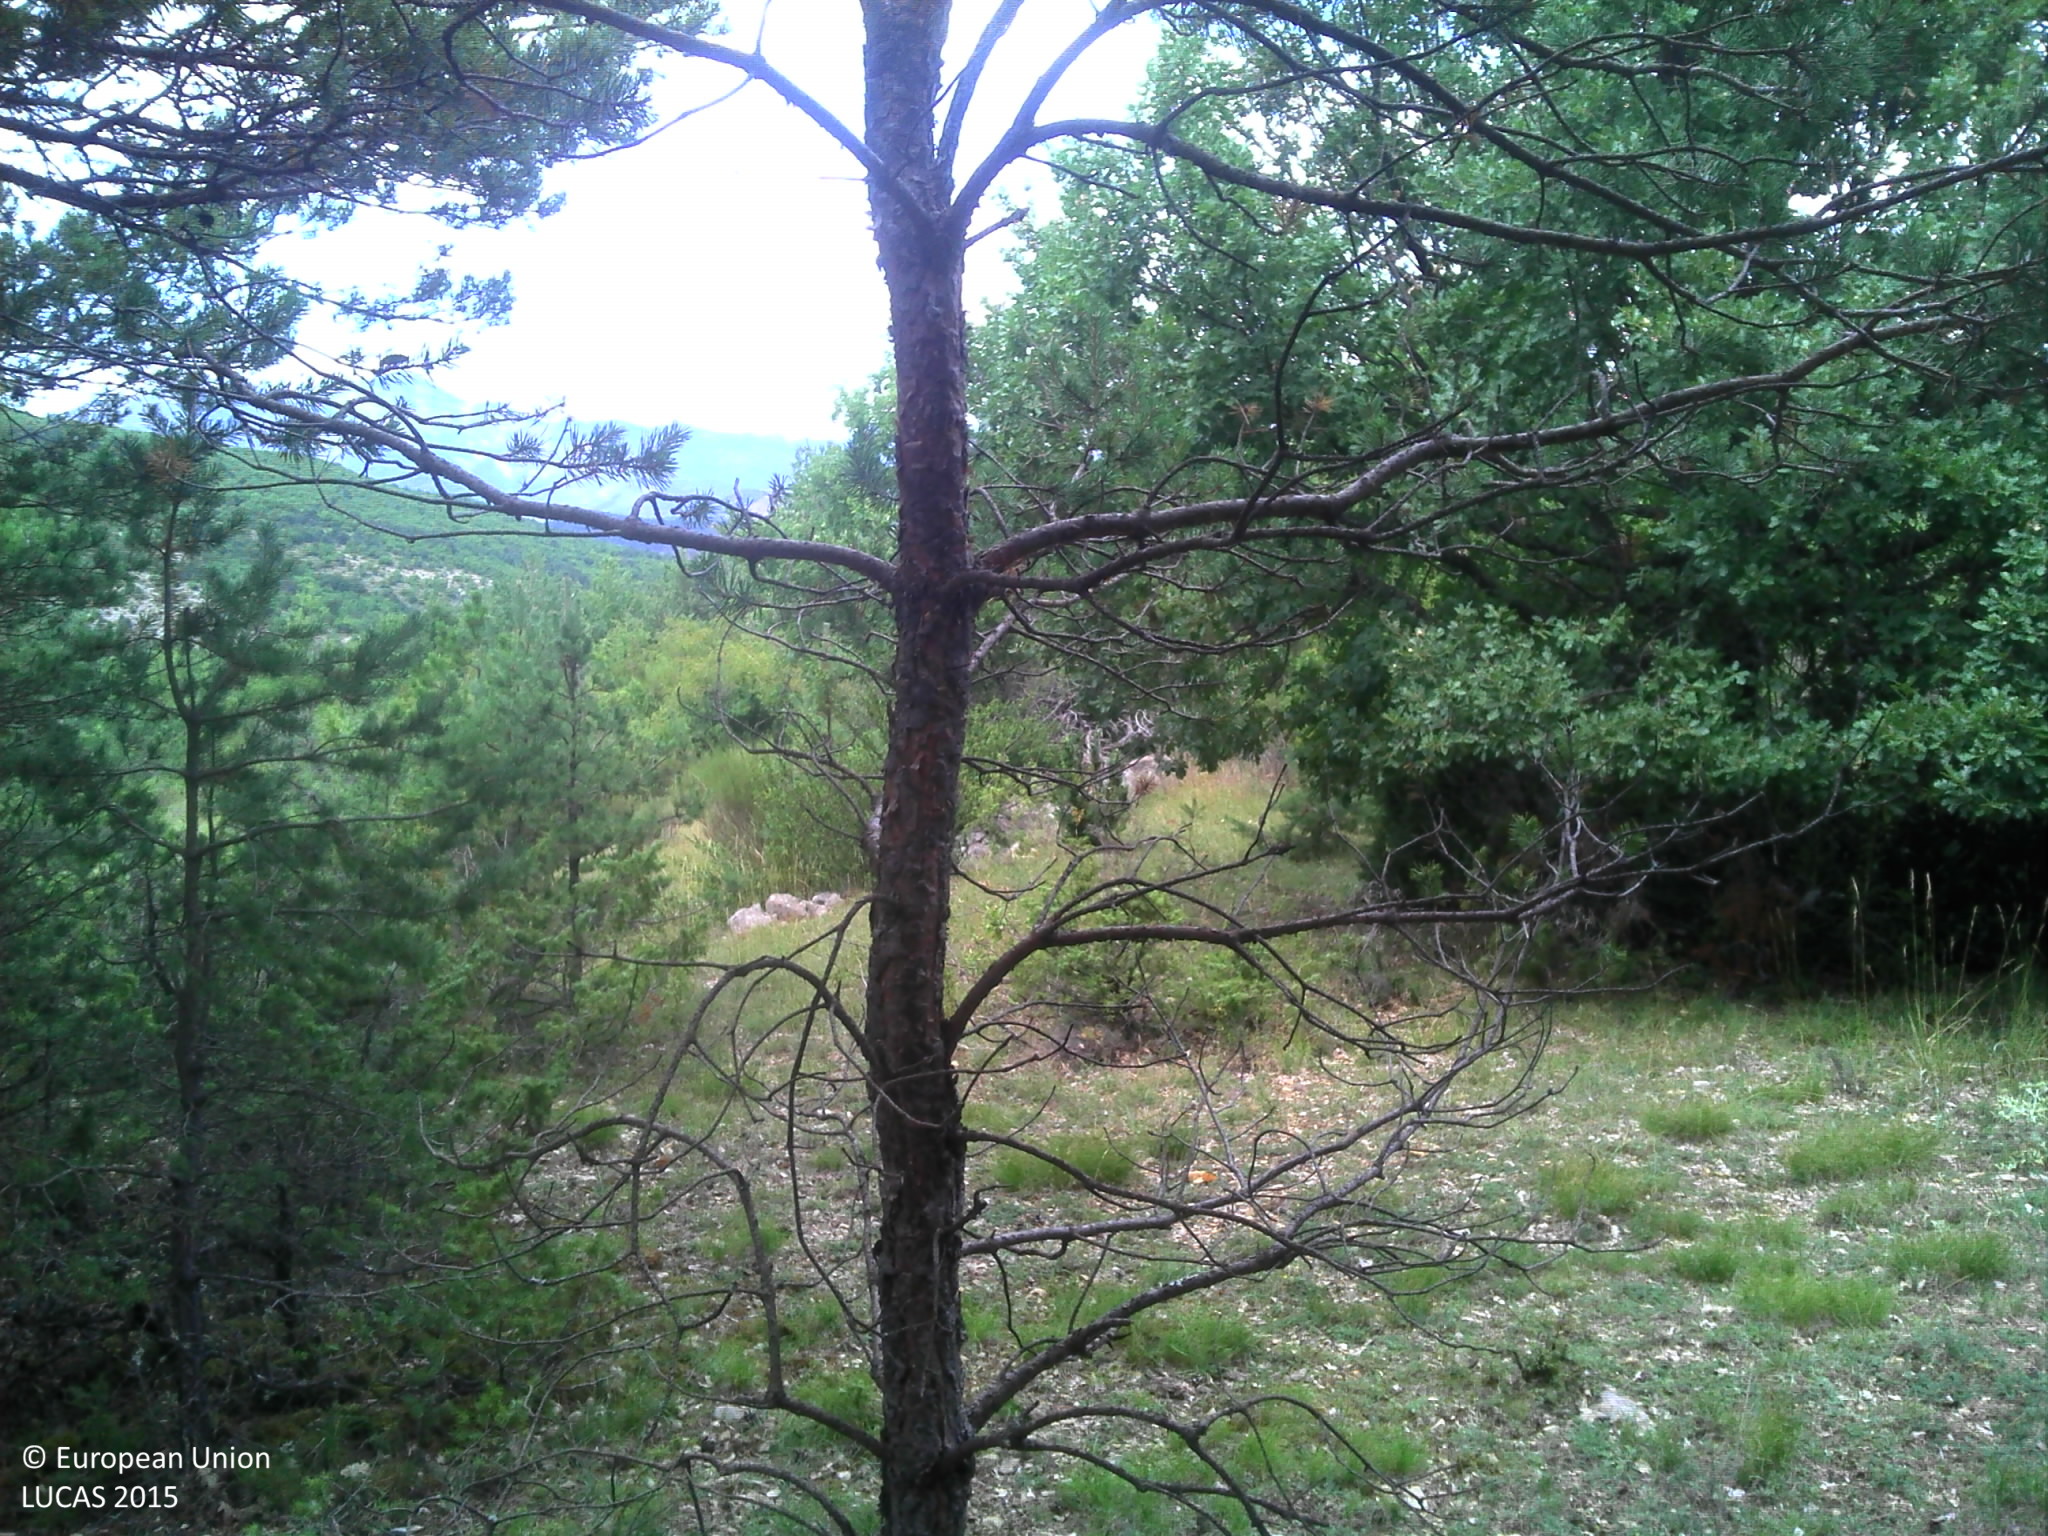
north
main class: Woodland
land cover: Pine dominated coniferous woodland
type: alpine coniferous forest
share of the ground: 50 - 75 %
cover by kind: coniferous forest trees 90 %, consolidated bare surface 10 %
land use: Semi-natural and natural areas not in use
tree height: > 5 m
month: August
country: FR
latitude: 44.0679
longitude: 6.2994
